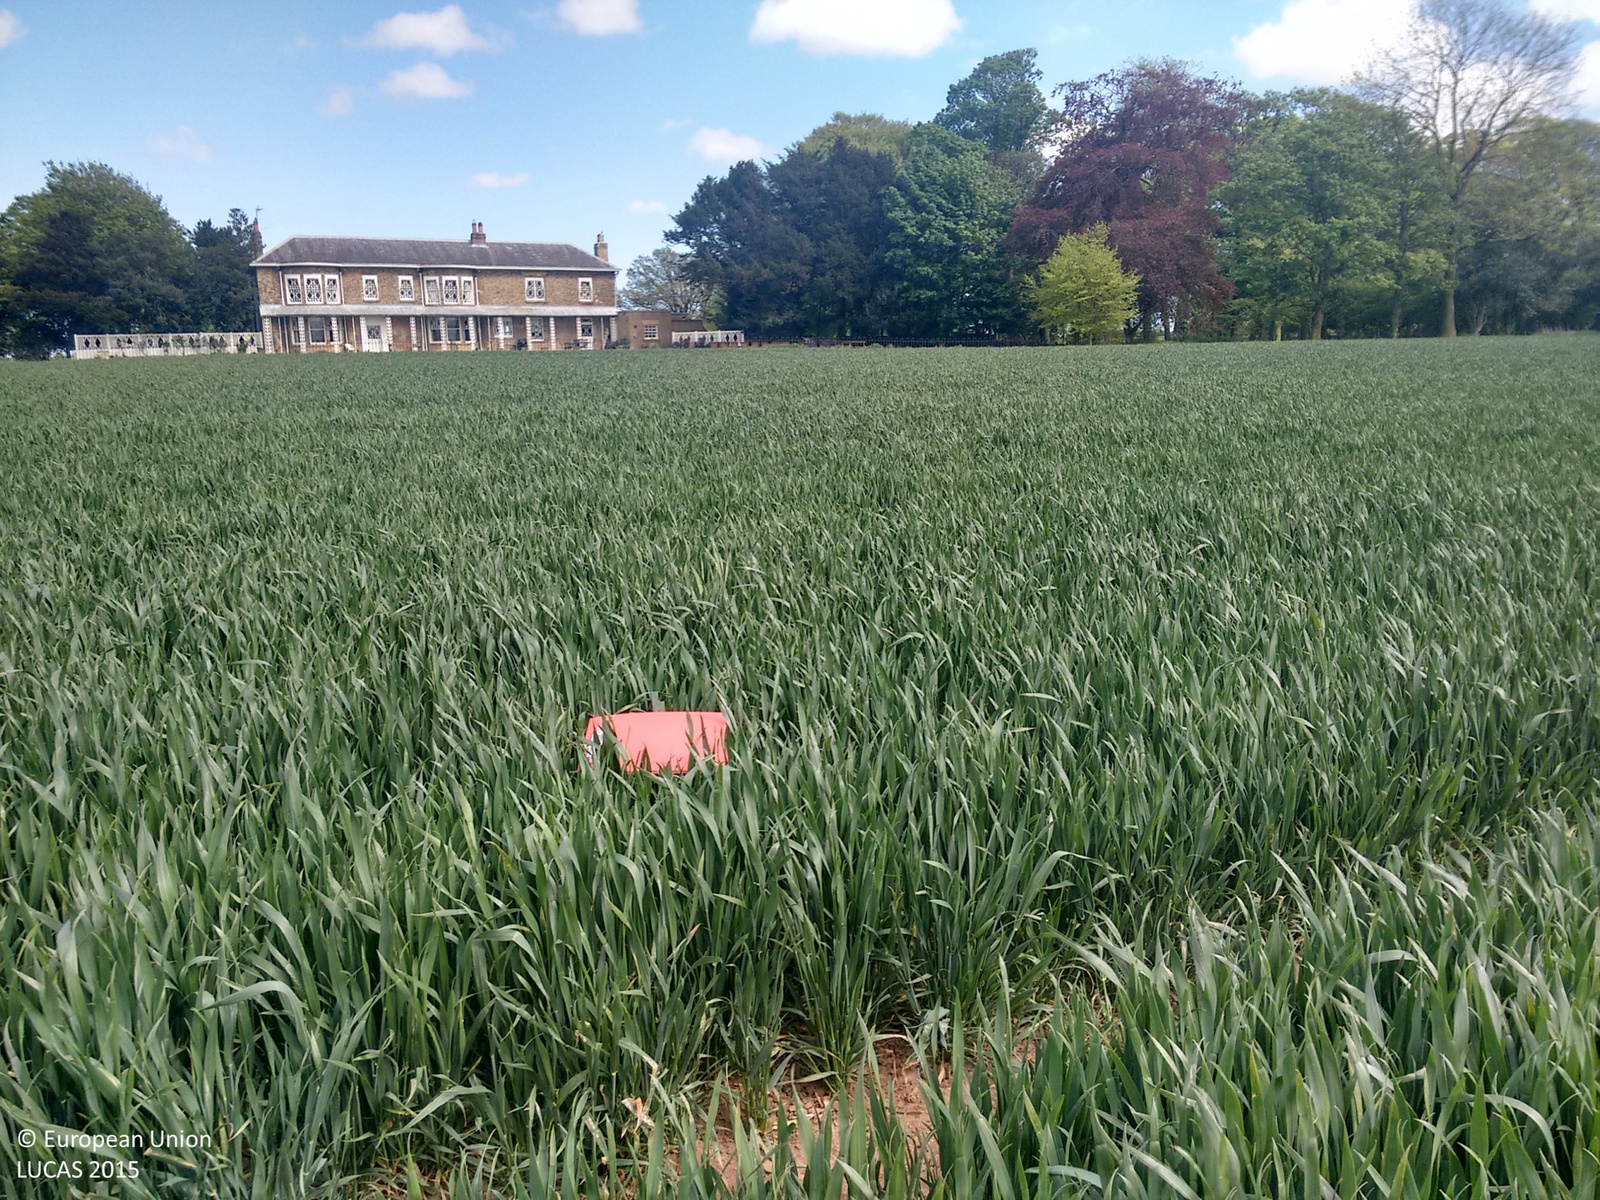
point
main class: Cropland
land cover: Common wheat
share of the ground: > 75 %
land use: Agriculture (excluding fallow land and kitchen gardens)
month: May
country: GB
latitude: 53.8326
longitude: -0.2908
